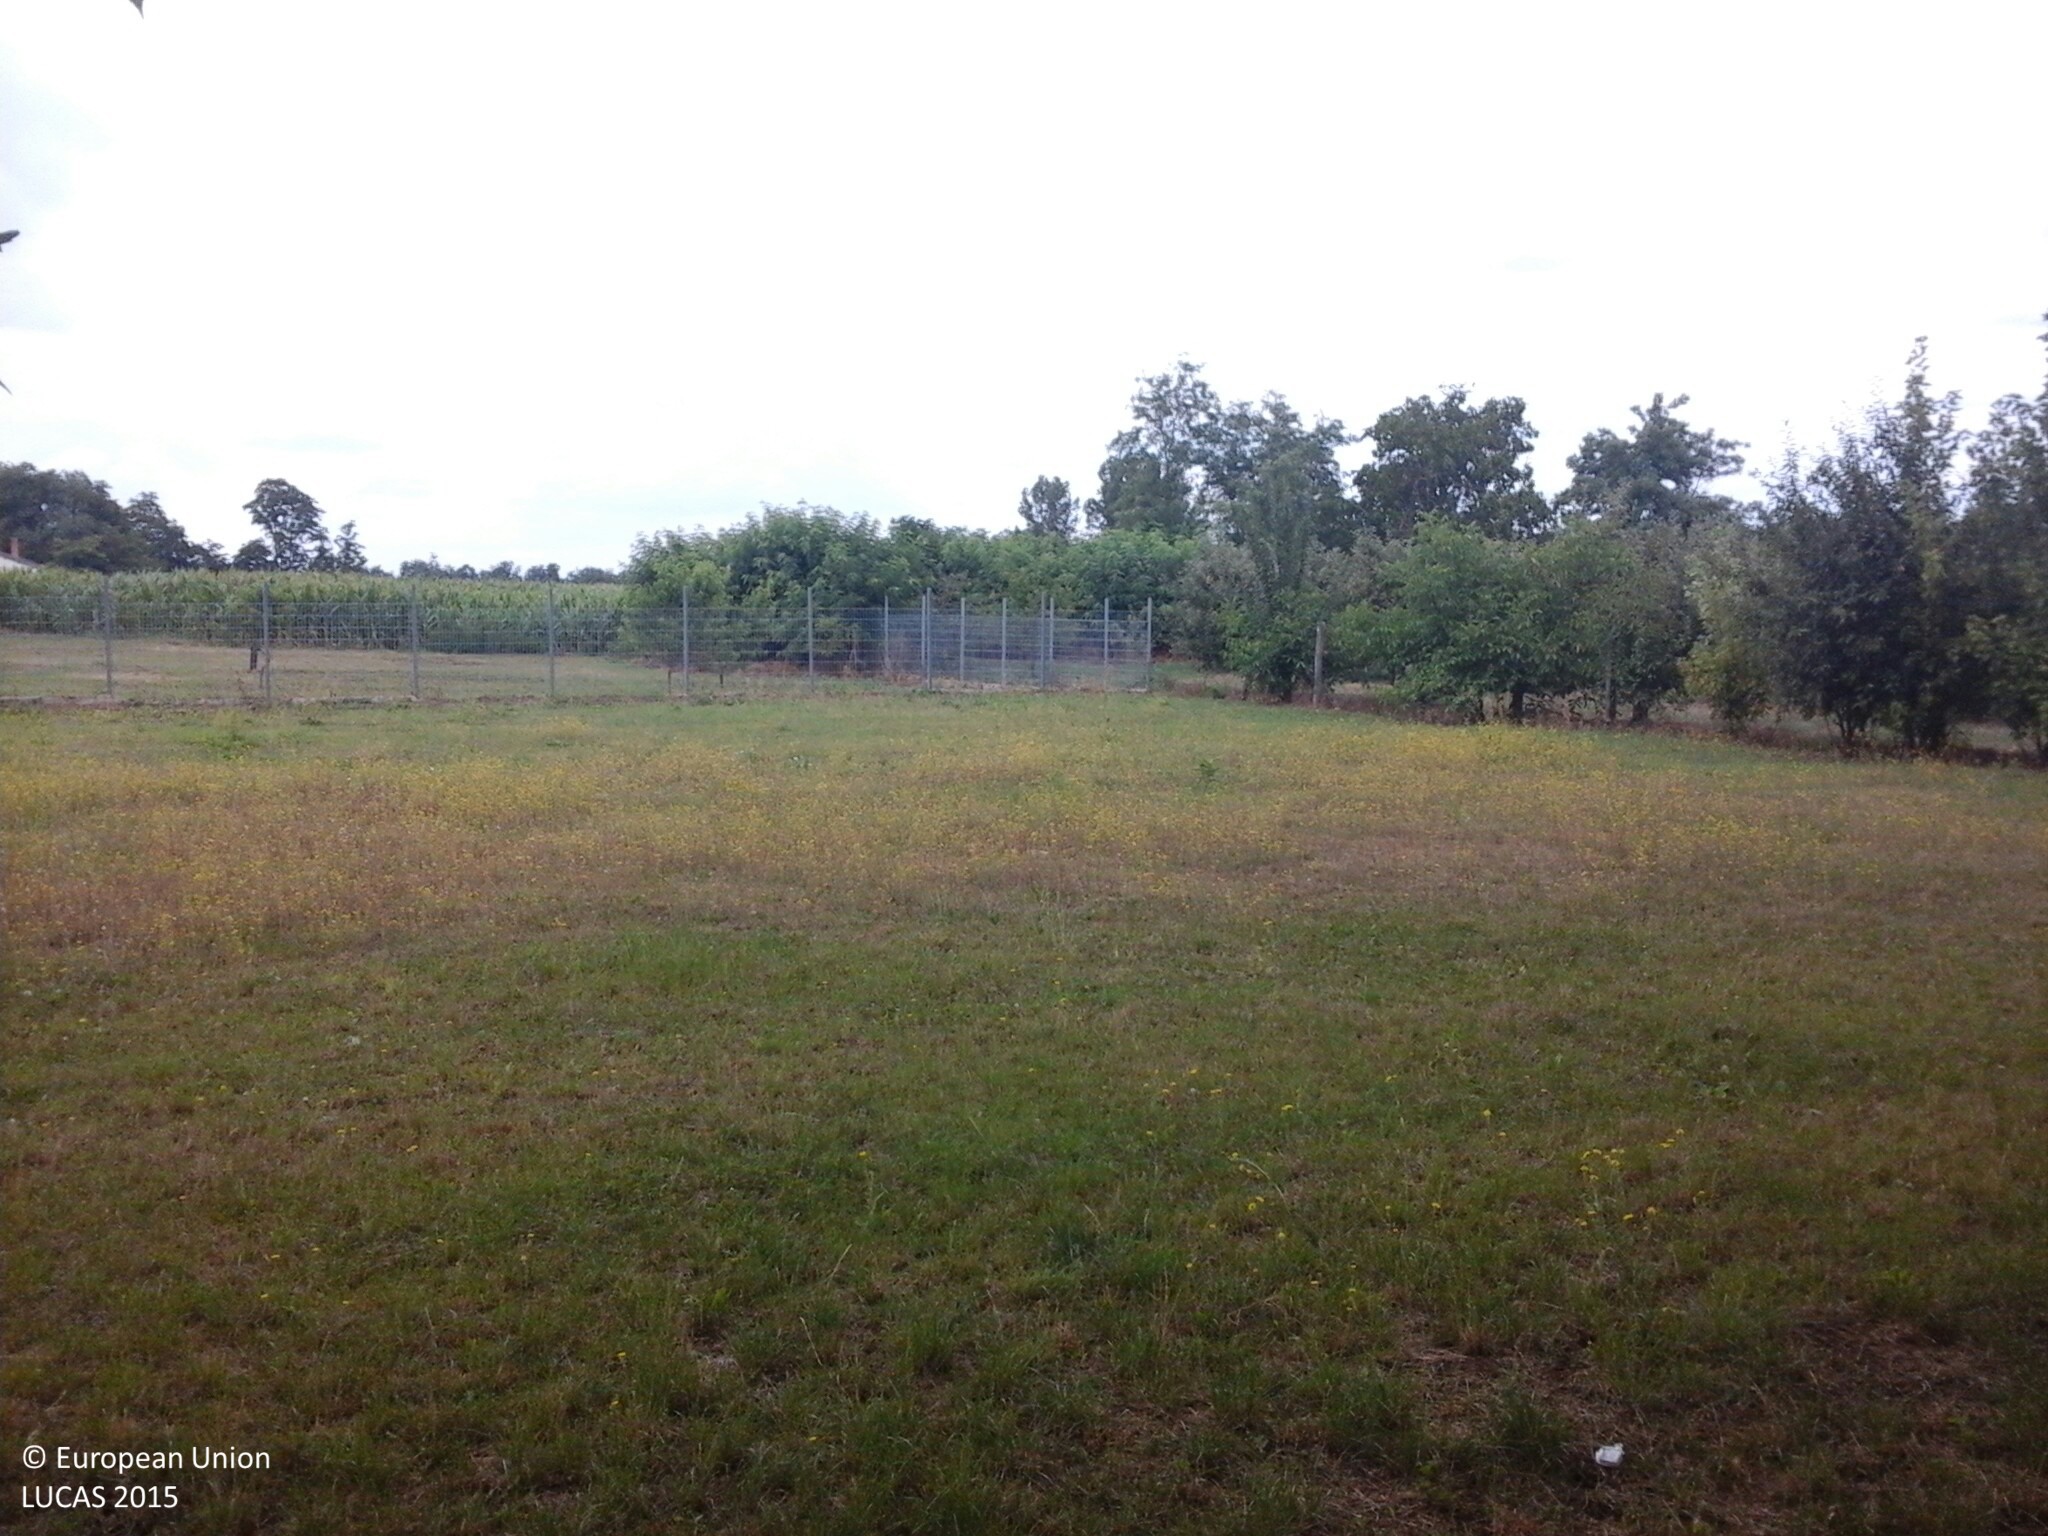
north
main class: Grassland
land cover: Grassland with sparse tree/shrub cover
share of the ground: > 75 %
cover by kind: herbaceous plants 95 %, broadleaved forest trees 5 %
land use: Amenities, museums, leisure
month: July
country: HU
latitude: 48.2005
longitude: 22.1782
